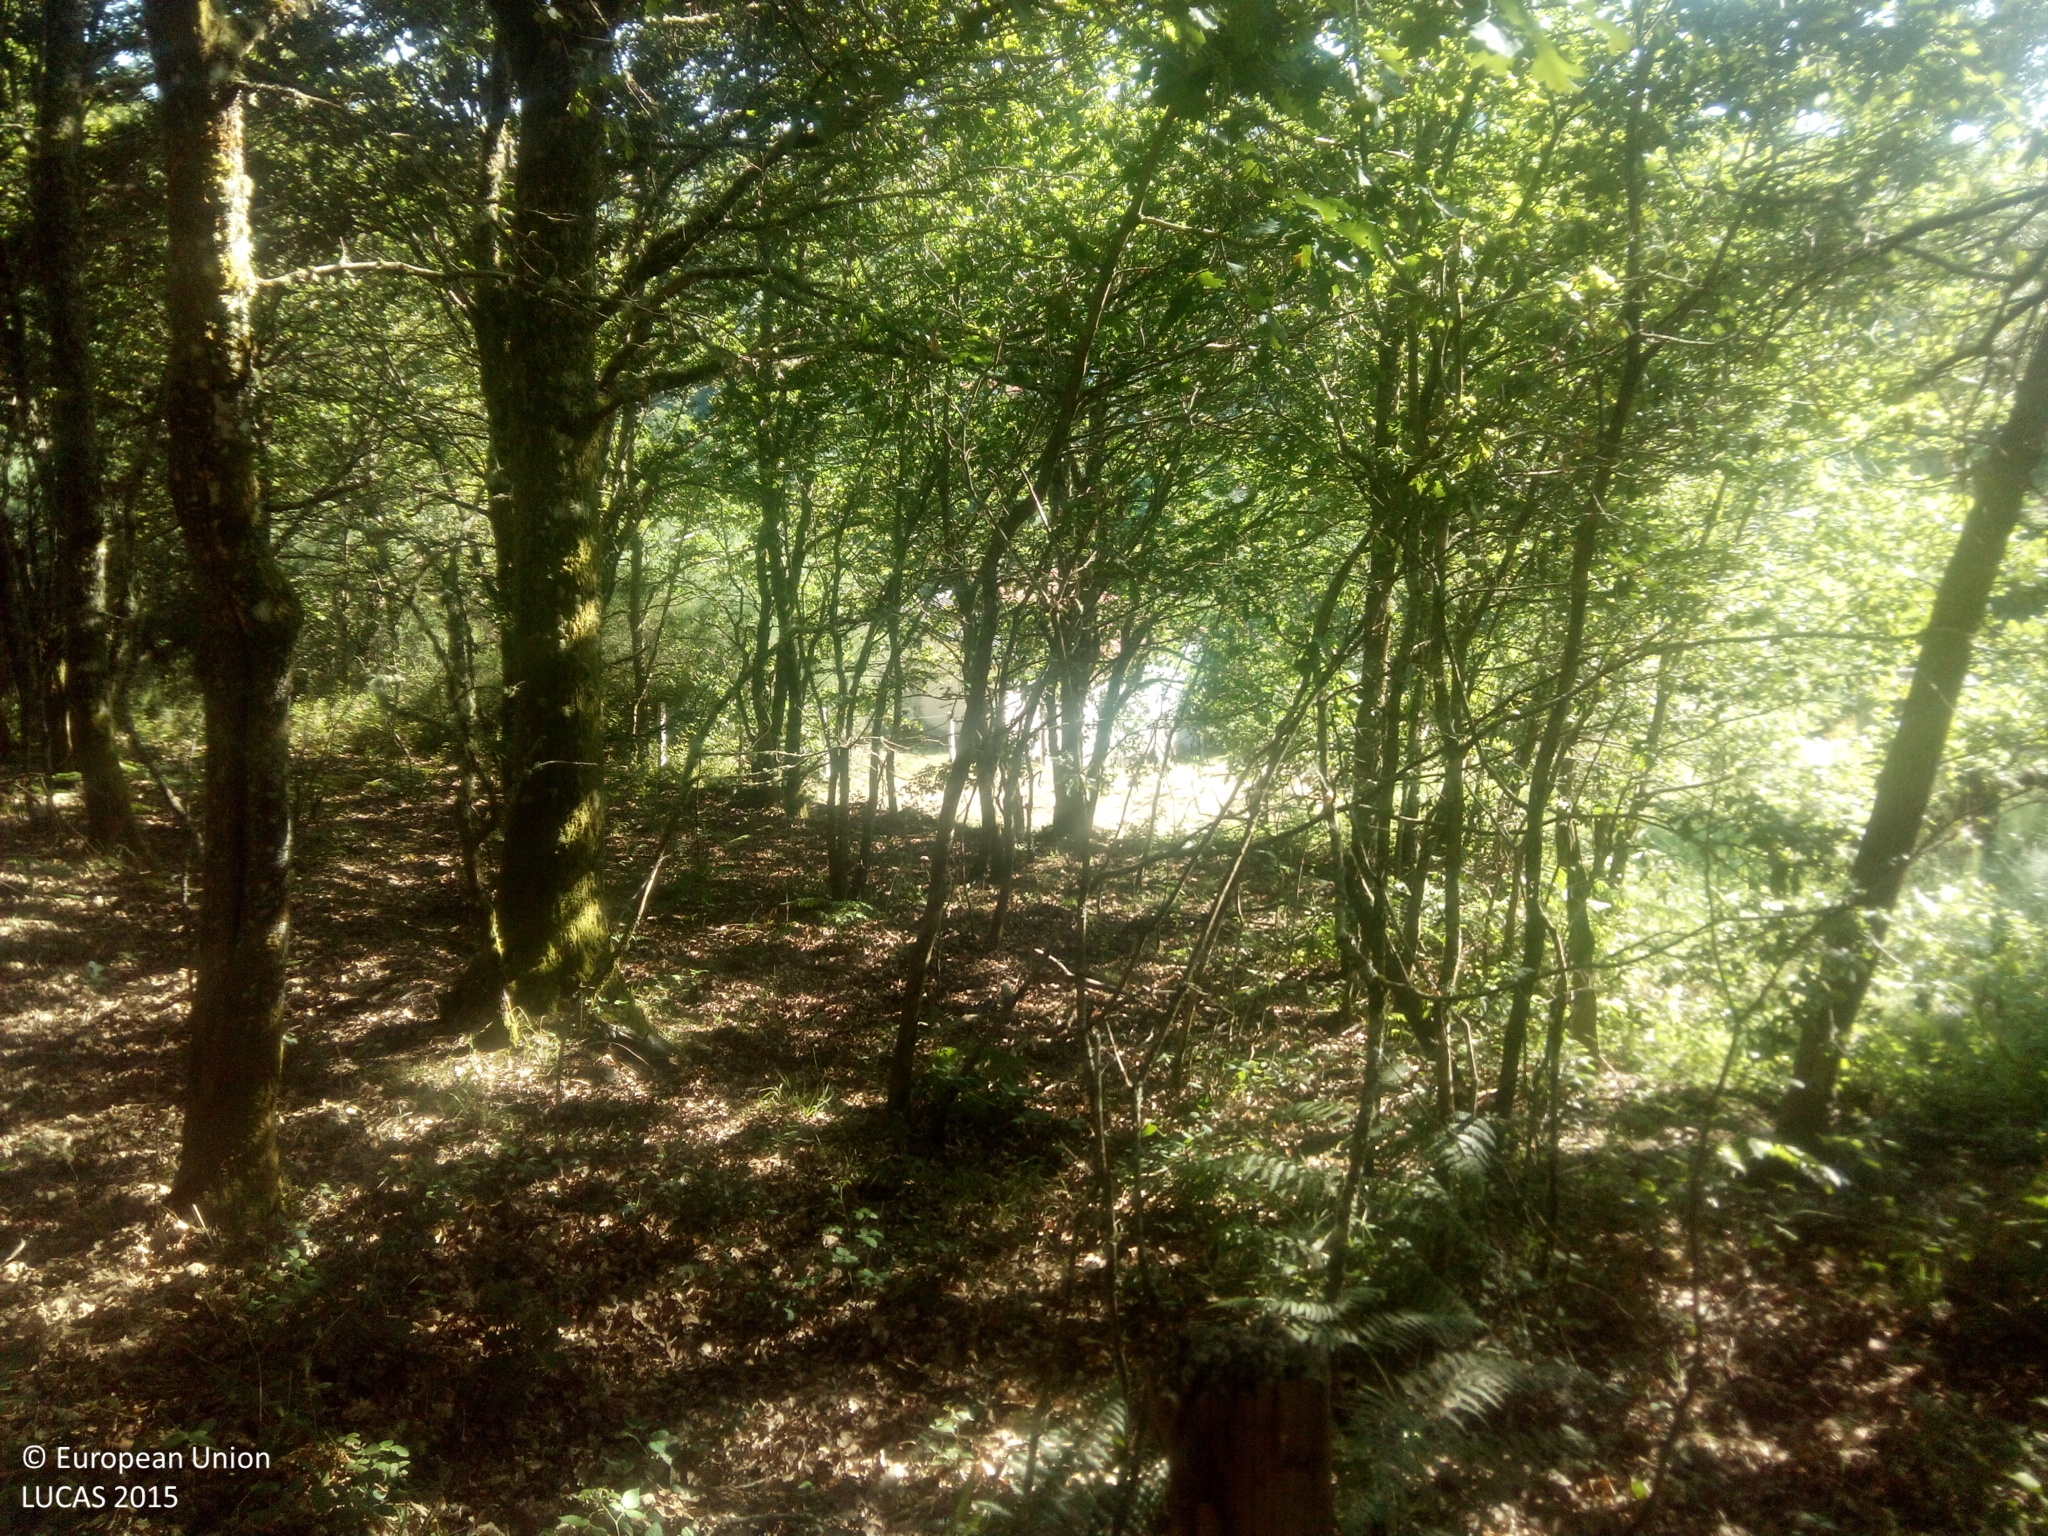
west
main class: Woodland
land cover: Broadleaved woodland
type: acidophilous oak and oak-birch forest
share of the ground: > 75 %
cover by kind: broadleaved forest trees 100 %
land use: Forestry
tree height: > 5 m
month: June
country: ES
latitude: 42.4313
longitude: -8.2871
